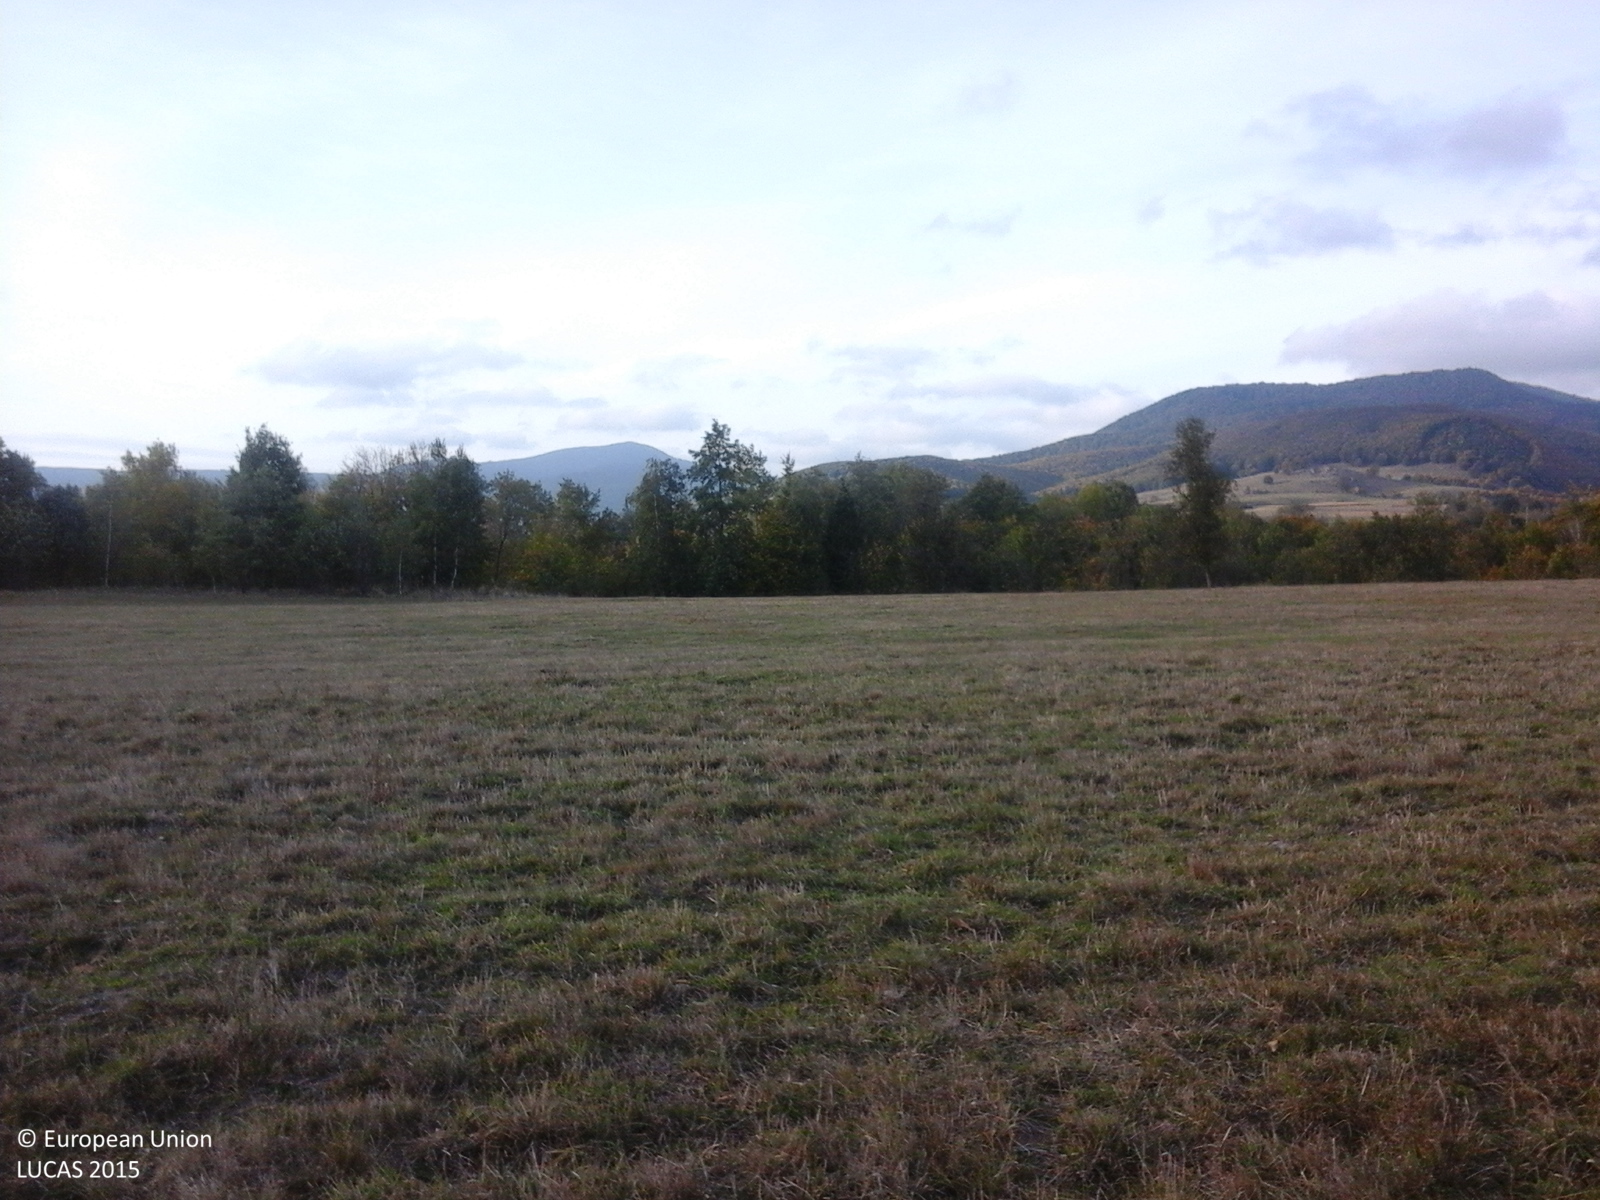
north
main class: Grassland
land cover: Grassland without tree/shrub cover
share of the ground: > 75 %
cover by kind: herbaceous plants 100 %
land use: Agriculture (excluding fallow land and kitchen gardens)
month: October
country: RO
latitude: 46.0906
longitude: 25.8808
